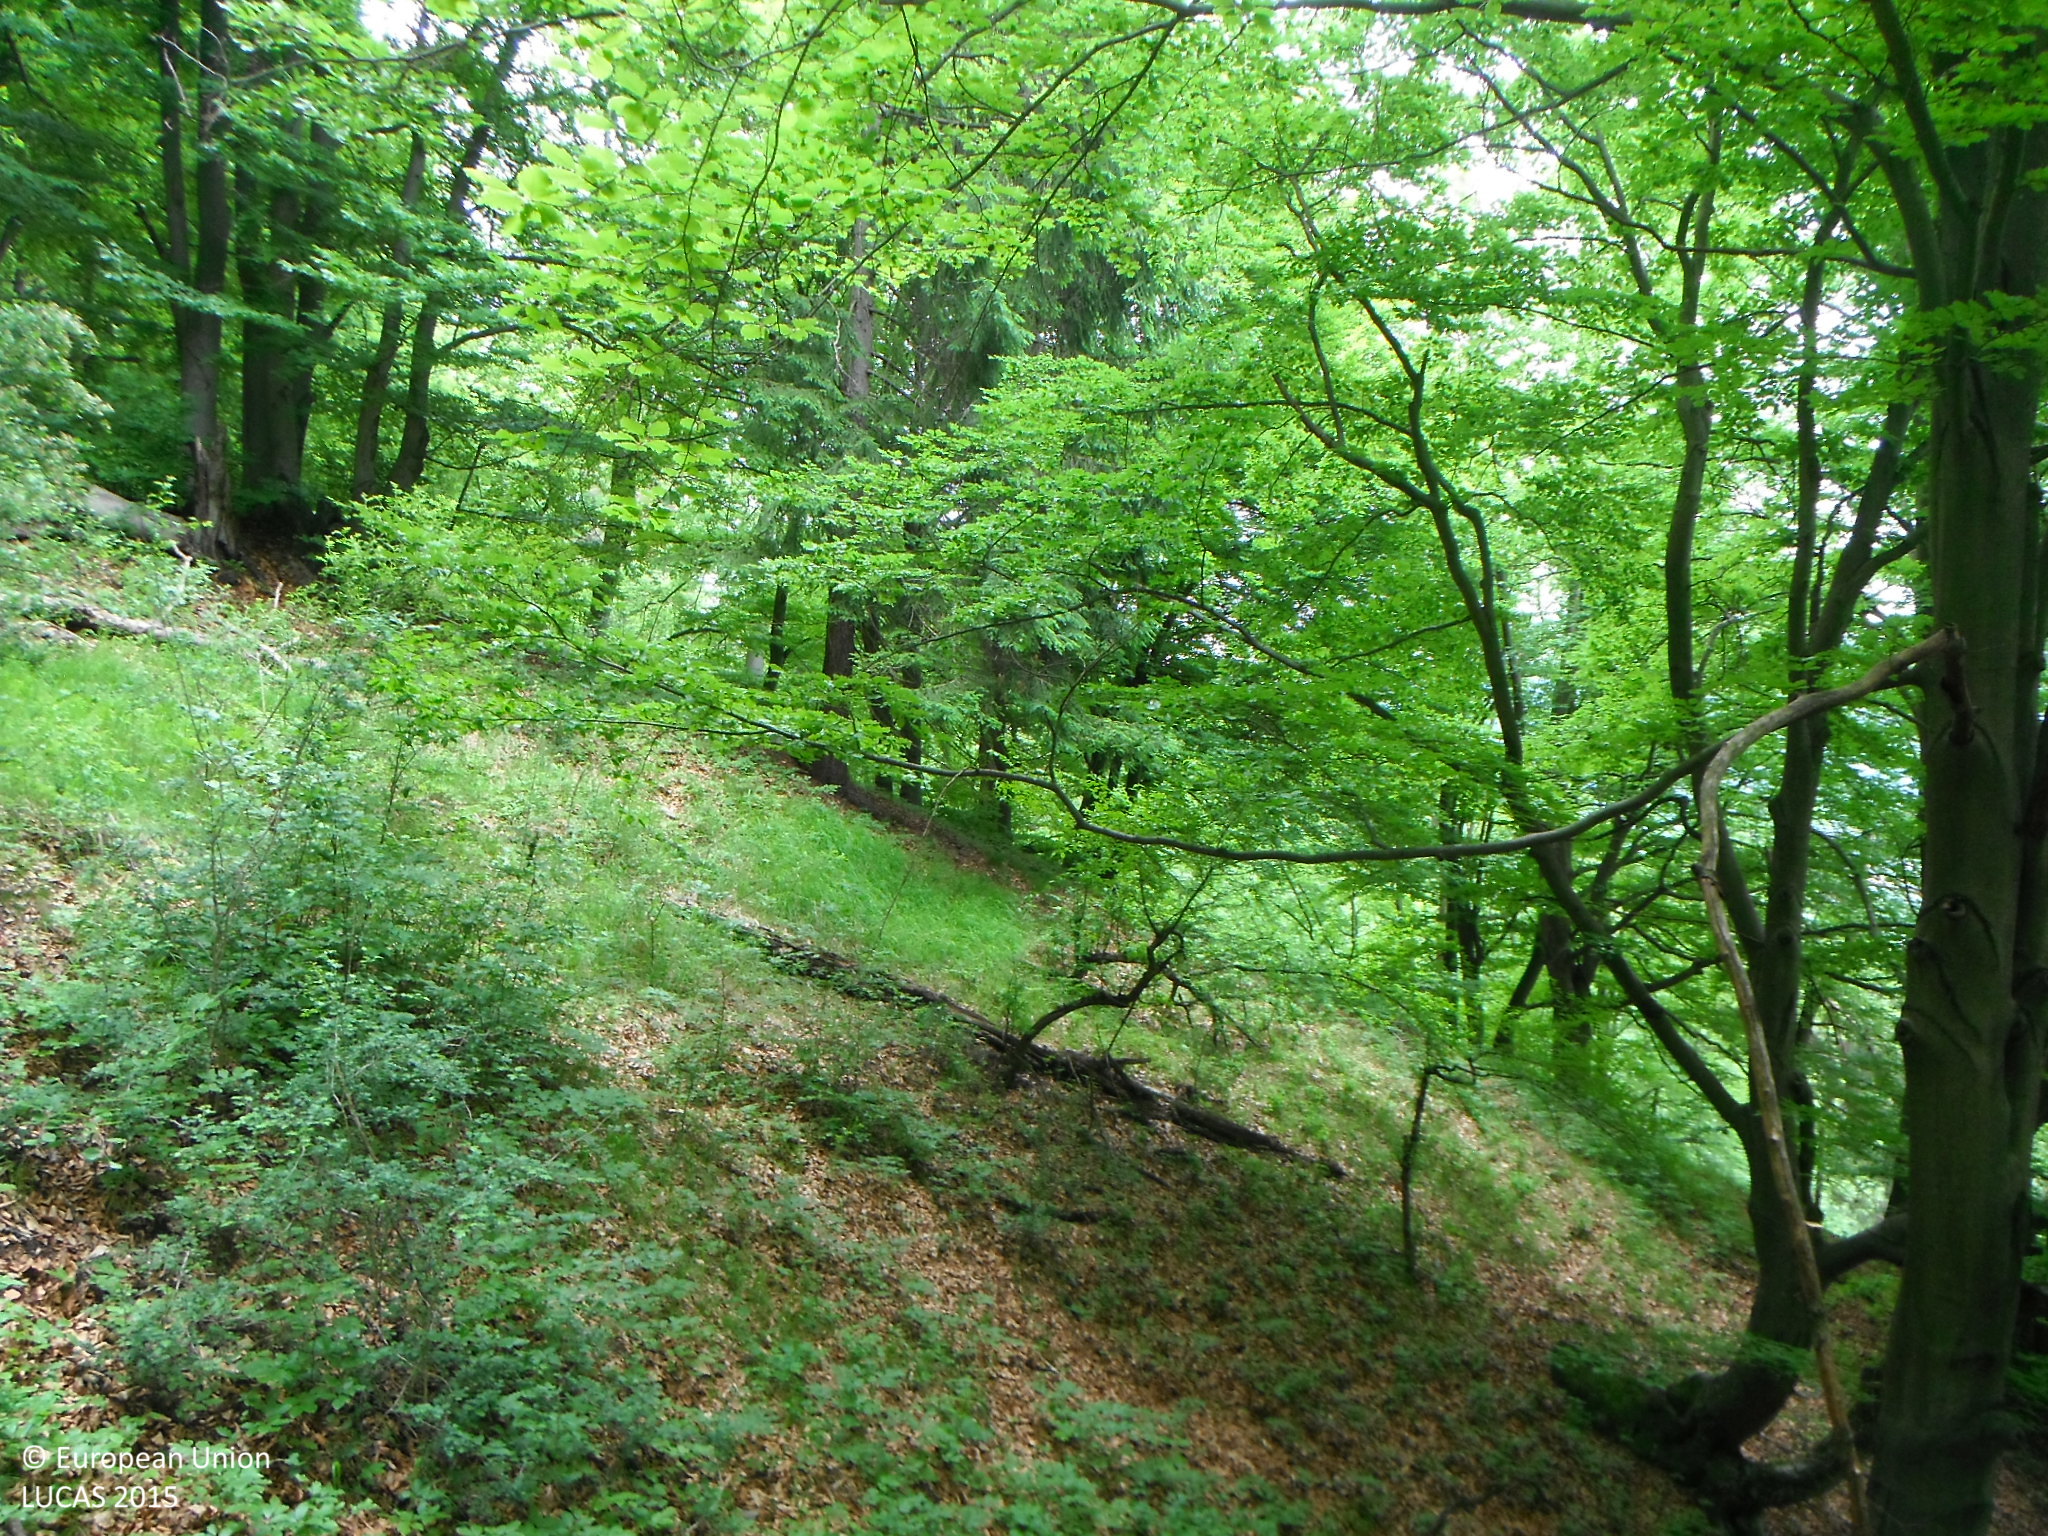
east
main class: Woodland
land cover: Broadleaved woodland
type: mountainous beech forest
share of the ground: > 75 %
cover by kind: broadleaved forest trees 100 %
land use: Forestry
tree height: > 5 m
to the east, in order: Broadleaved woodland; Other mixed woodland
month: June
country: SK
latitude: 48.8034
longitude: 19.3506
